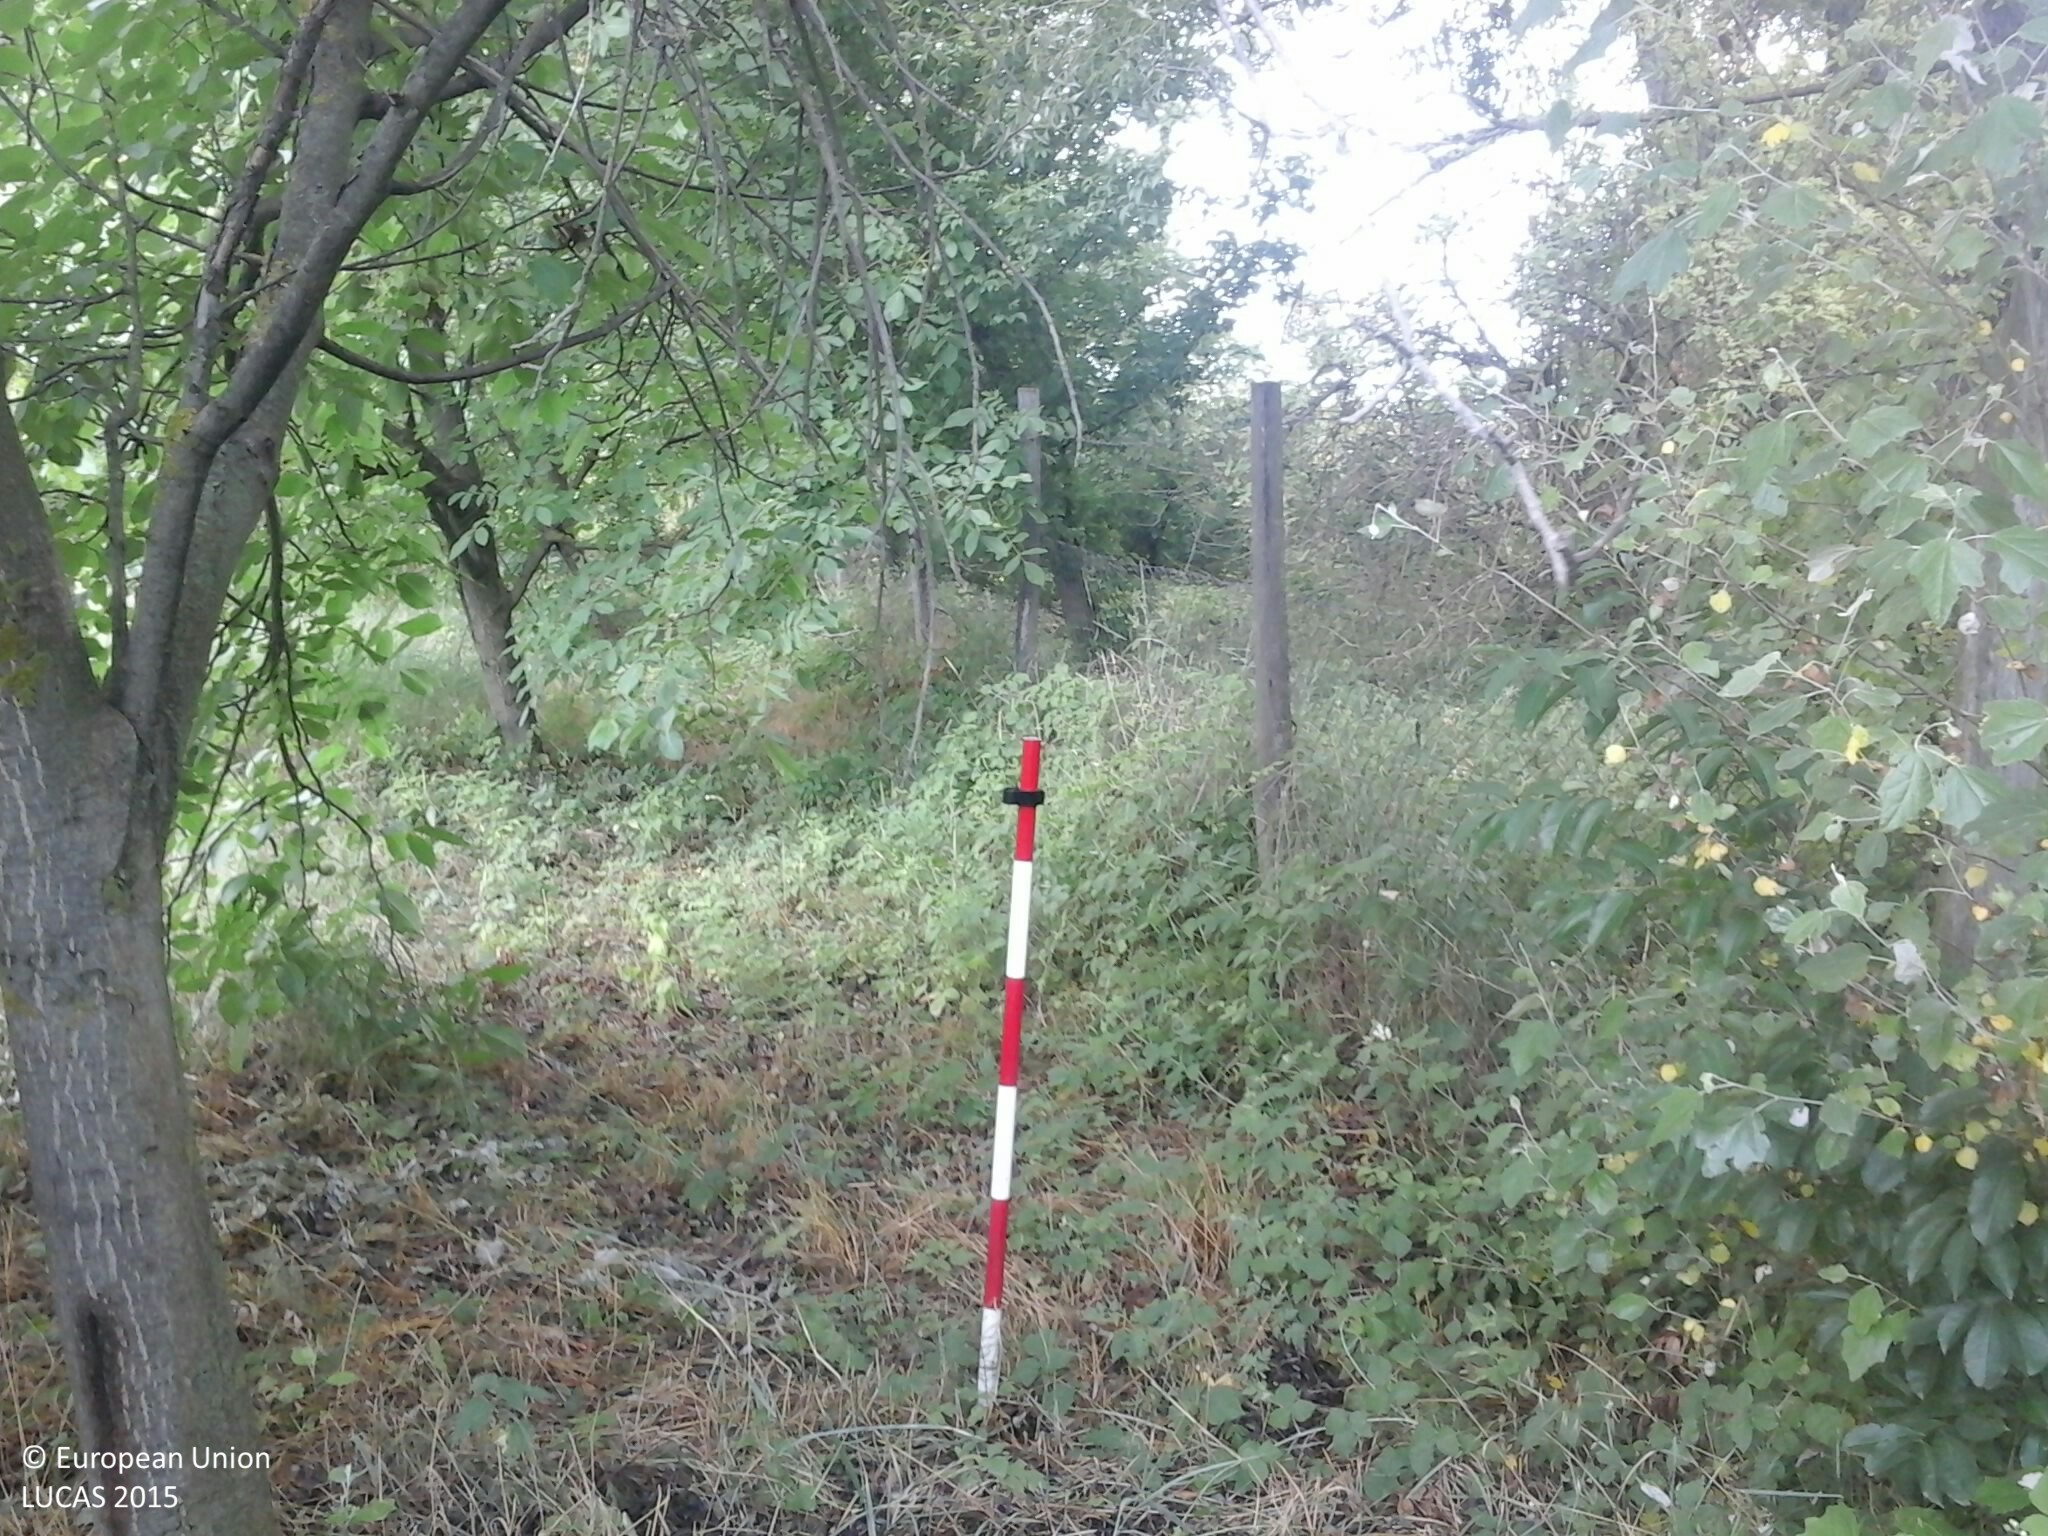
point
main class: Woodland
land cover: Broadleaved woodland
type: exotic forest
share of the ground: > 75 %
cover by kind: broadleaved forest trees 80 %, shrubs 10 %, herbaceous plants 10 %
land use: Abandoned areas
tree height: > 5 m
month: July
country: HU
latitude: 47.9022
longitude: 22.2419
